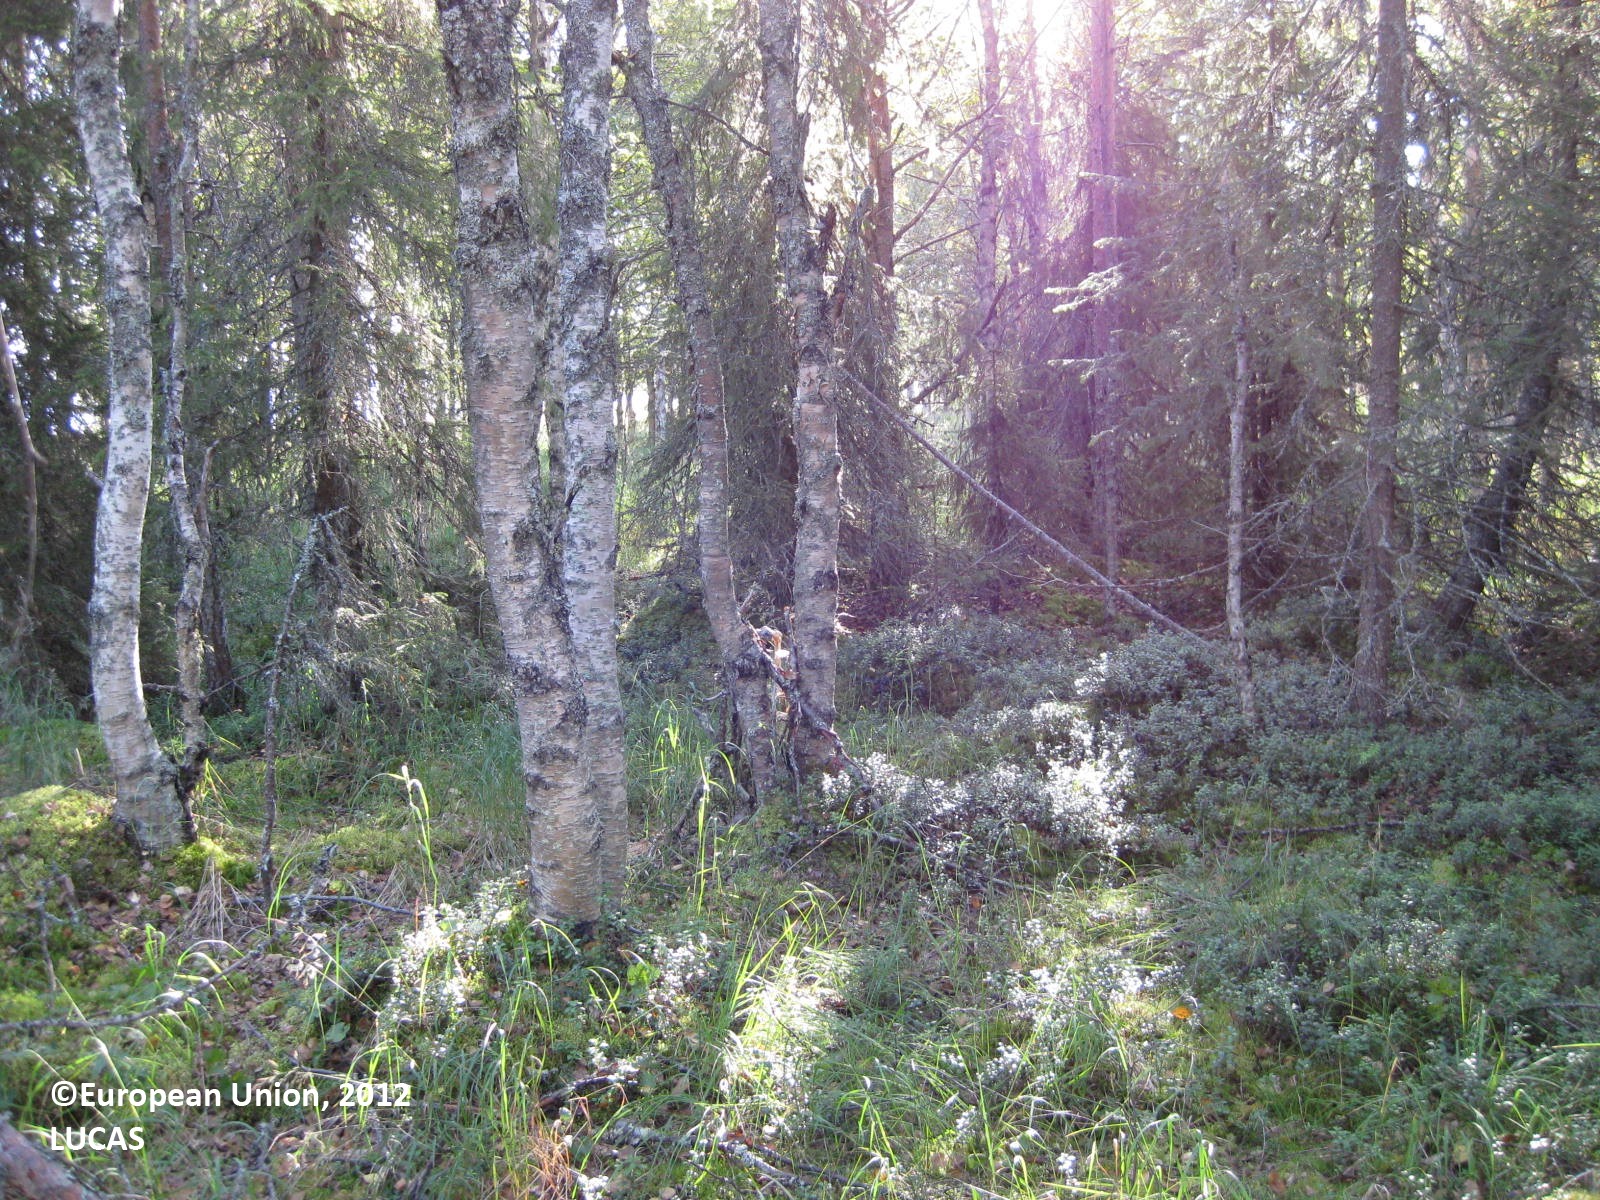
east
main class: Woodland
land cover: Other mixed woodland
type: boreal forest
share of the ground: > 75 %
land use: Forestry
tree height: > 5 m
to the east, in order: Other mixed woodland; Ditches and canals; Broadleaved woodland; Ditches and canals; Broadleaved woodland; Inland water bodies
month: August
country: FI
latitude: 66.0520
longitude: 29.5542
